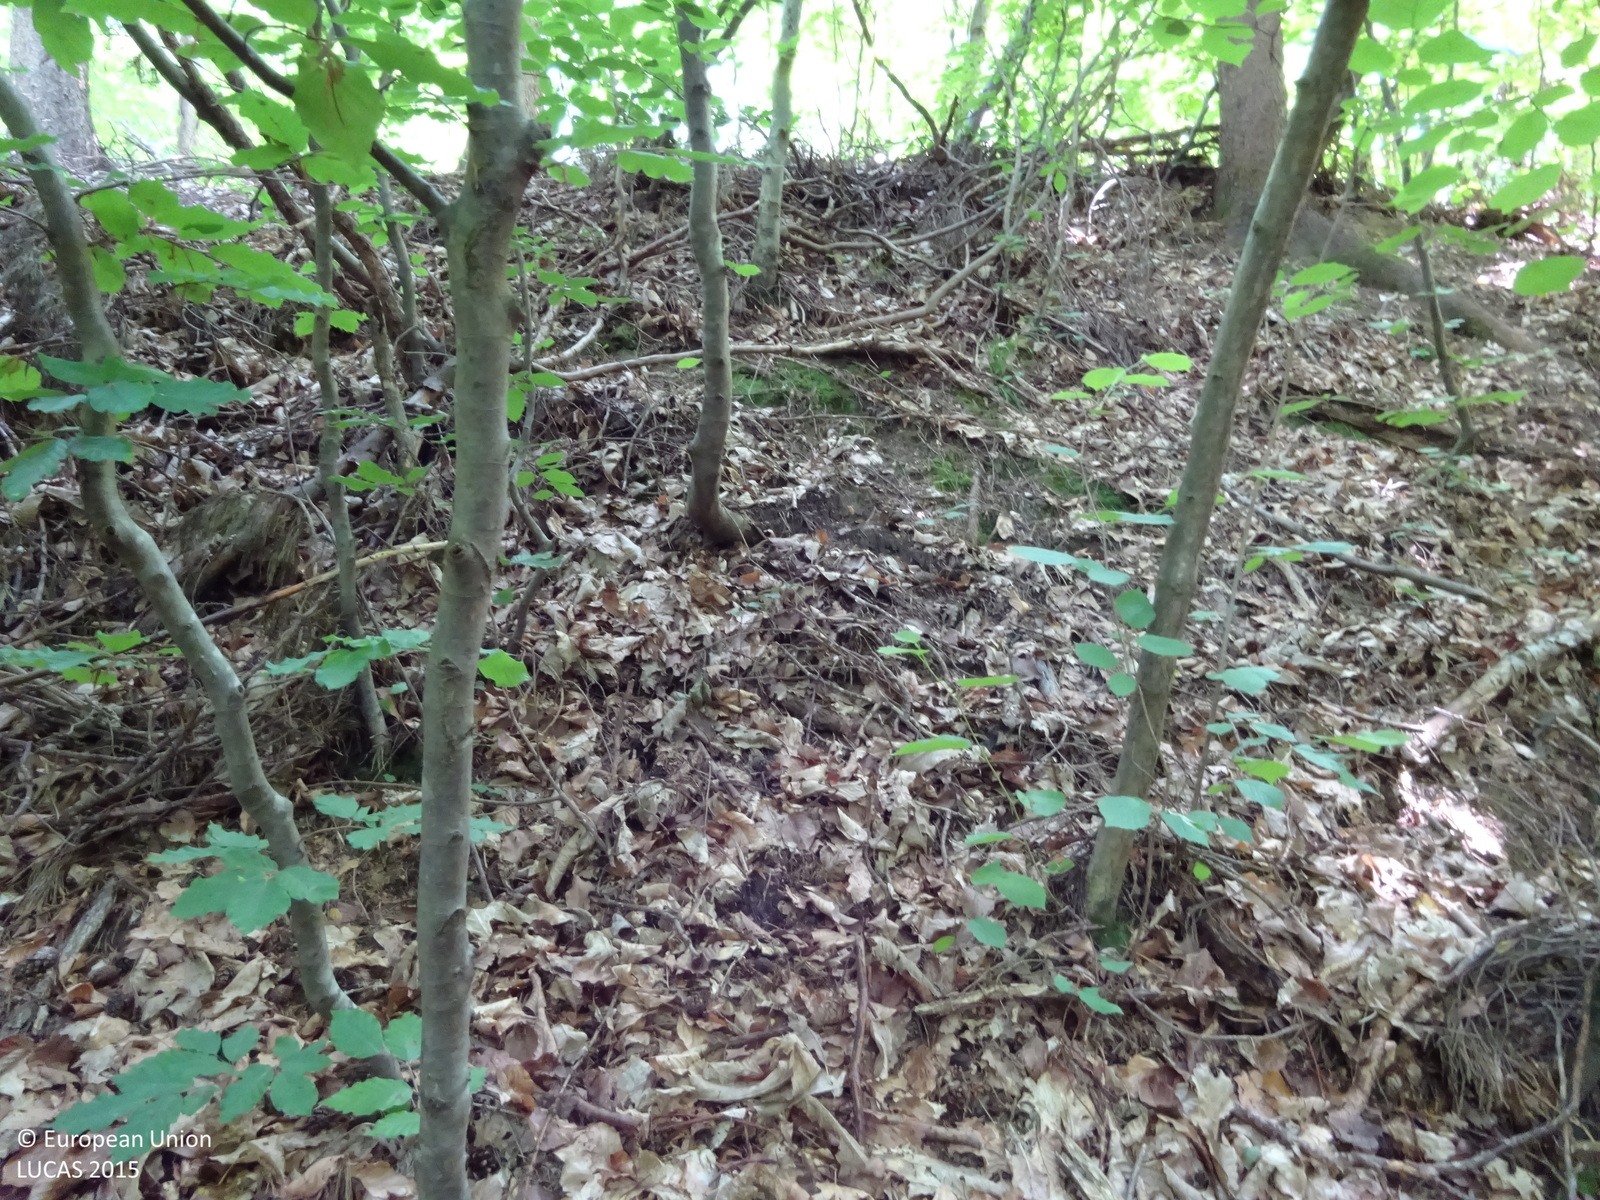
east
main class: Woodland
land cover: Broadleaved woodland
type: mountainous beech forest
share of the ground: > 75 %
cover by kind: broadleaved forest trees 100 %
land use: Forestry
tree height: > 5 m
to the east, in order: Broadleaved woodland; Pine dominated mixed woodland; Tracks; Broadleaved woodland; Spruce dominated mixed woodland; Broadleaved woodland
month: July
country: AT
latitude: 46.8633
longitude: 16.1007
